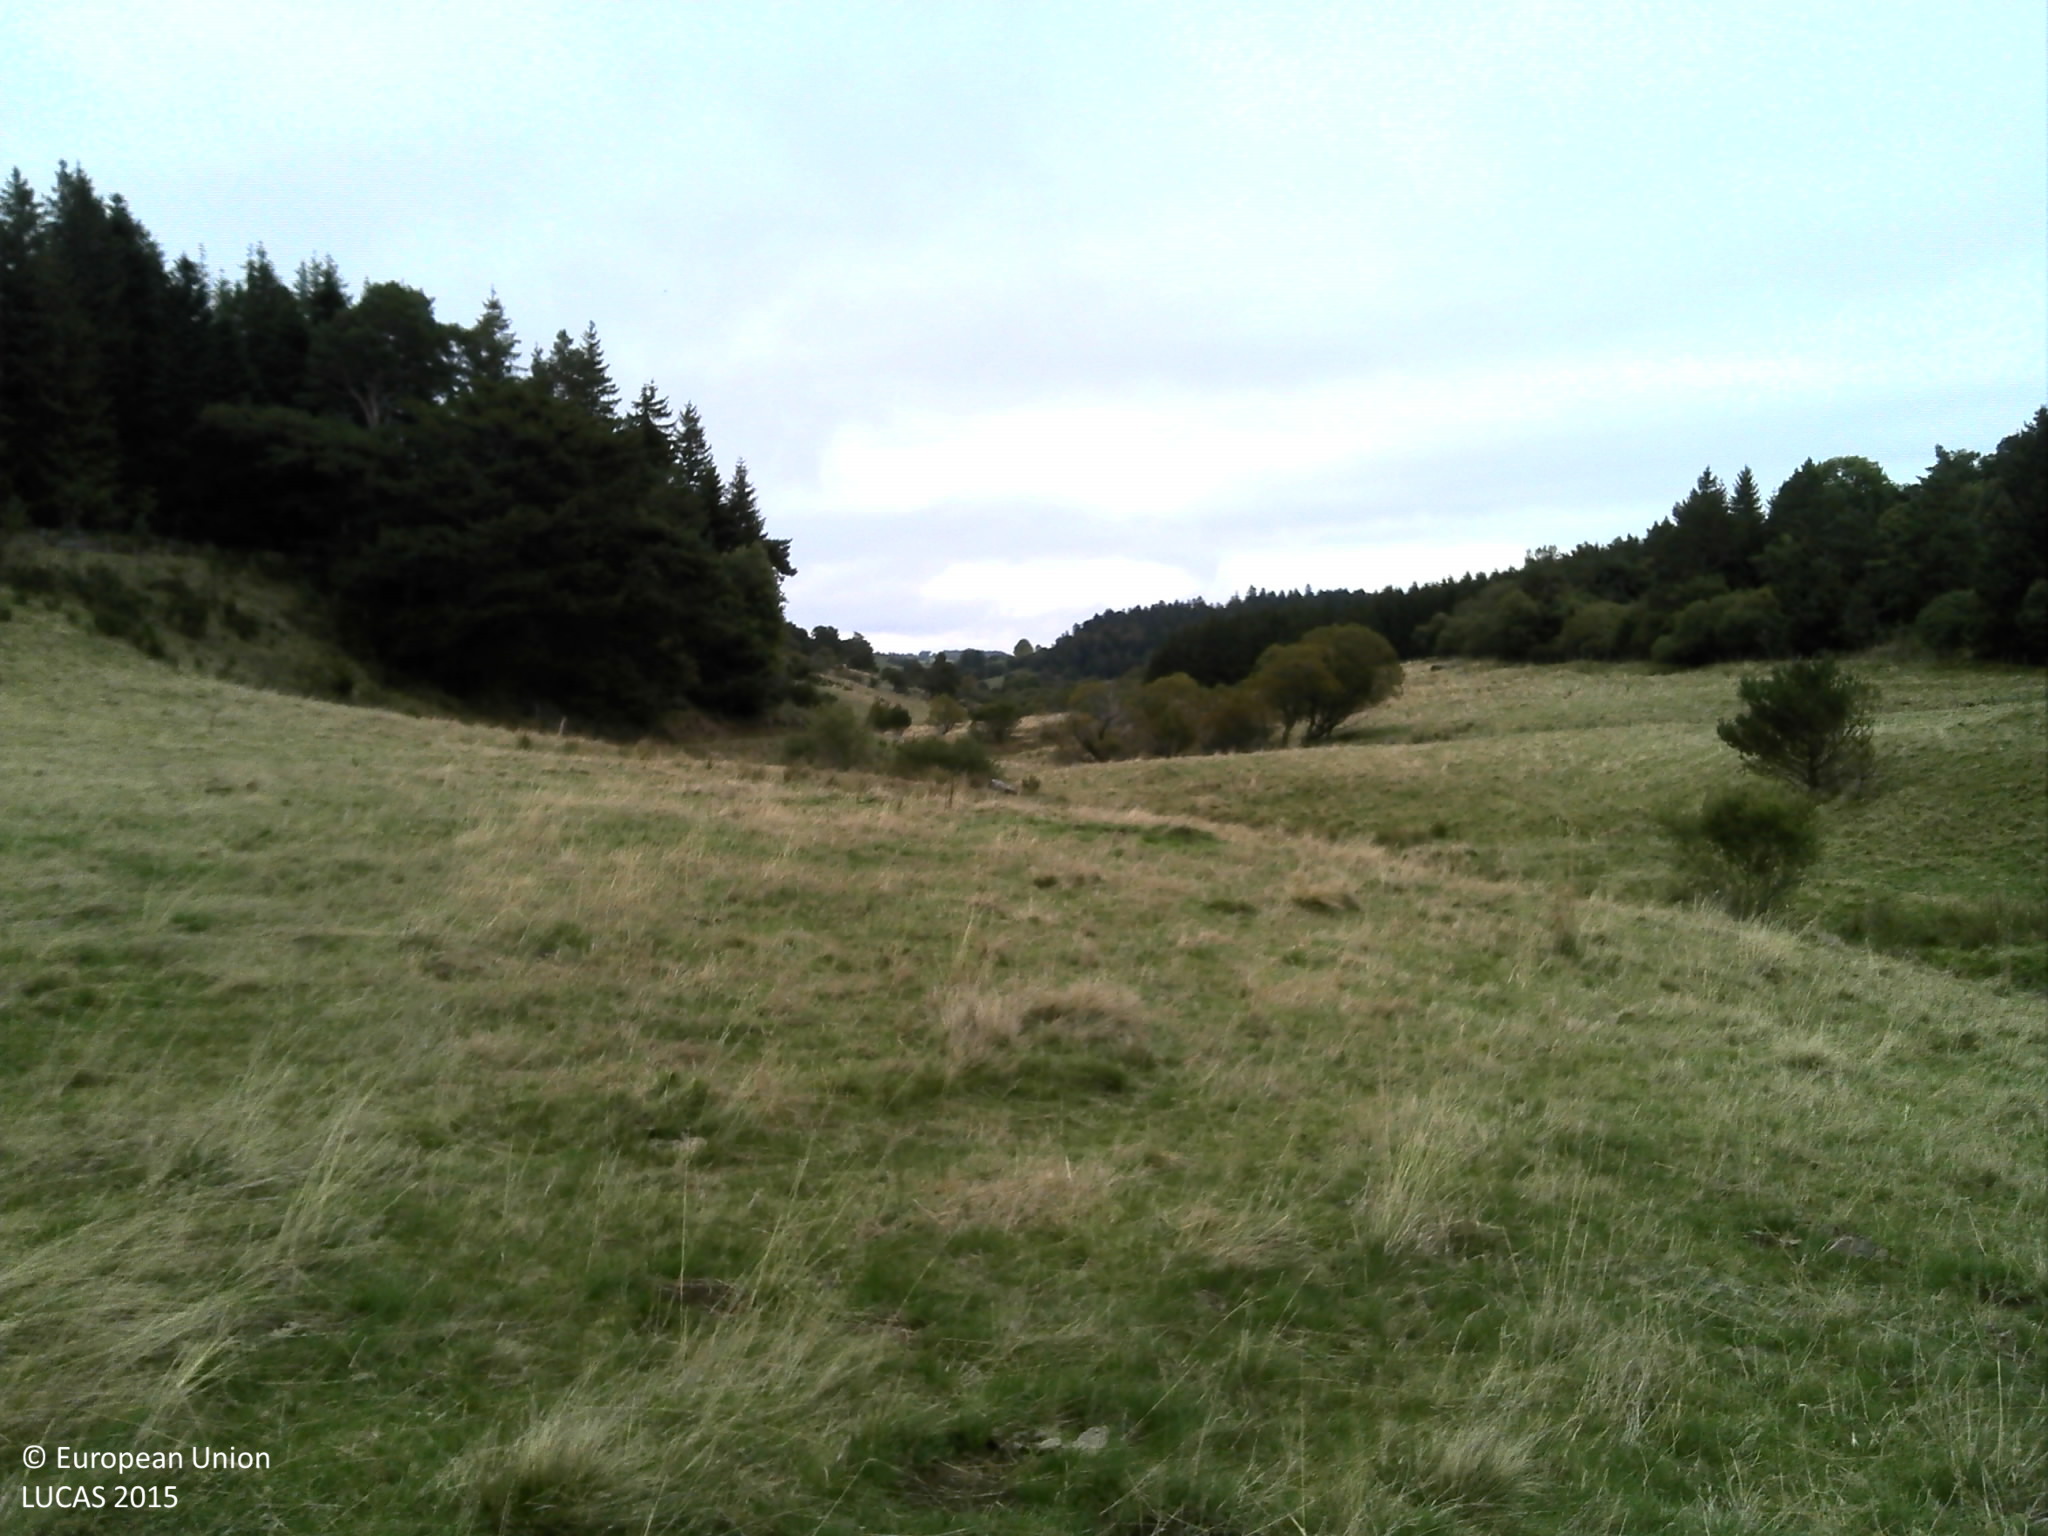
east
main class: Grassland
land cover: Grassland without tree/shrub cover
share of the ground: > 75 %
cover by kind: herbaceous plants 100 %
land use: Agriculture (excluding fallow land and kitchen gardens)
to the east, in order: Grassland without tree/shrub cover; Rivers and streams; Grassland without tree/shrub cover; Rivers and streams; Grassland without tree/shrub cover; Fences; Grassland without tree/shrub cover; Rivers and streams; Grassland with sparse tree/shrub cover; Ditches and canals; Grassland with sparse tree/shrub cover
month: September
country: FR
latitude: 45.5898
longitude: 2.8856
